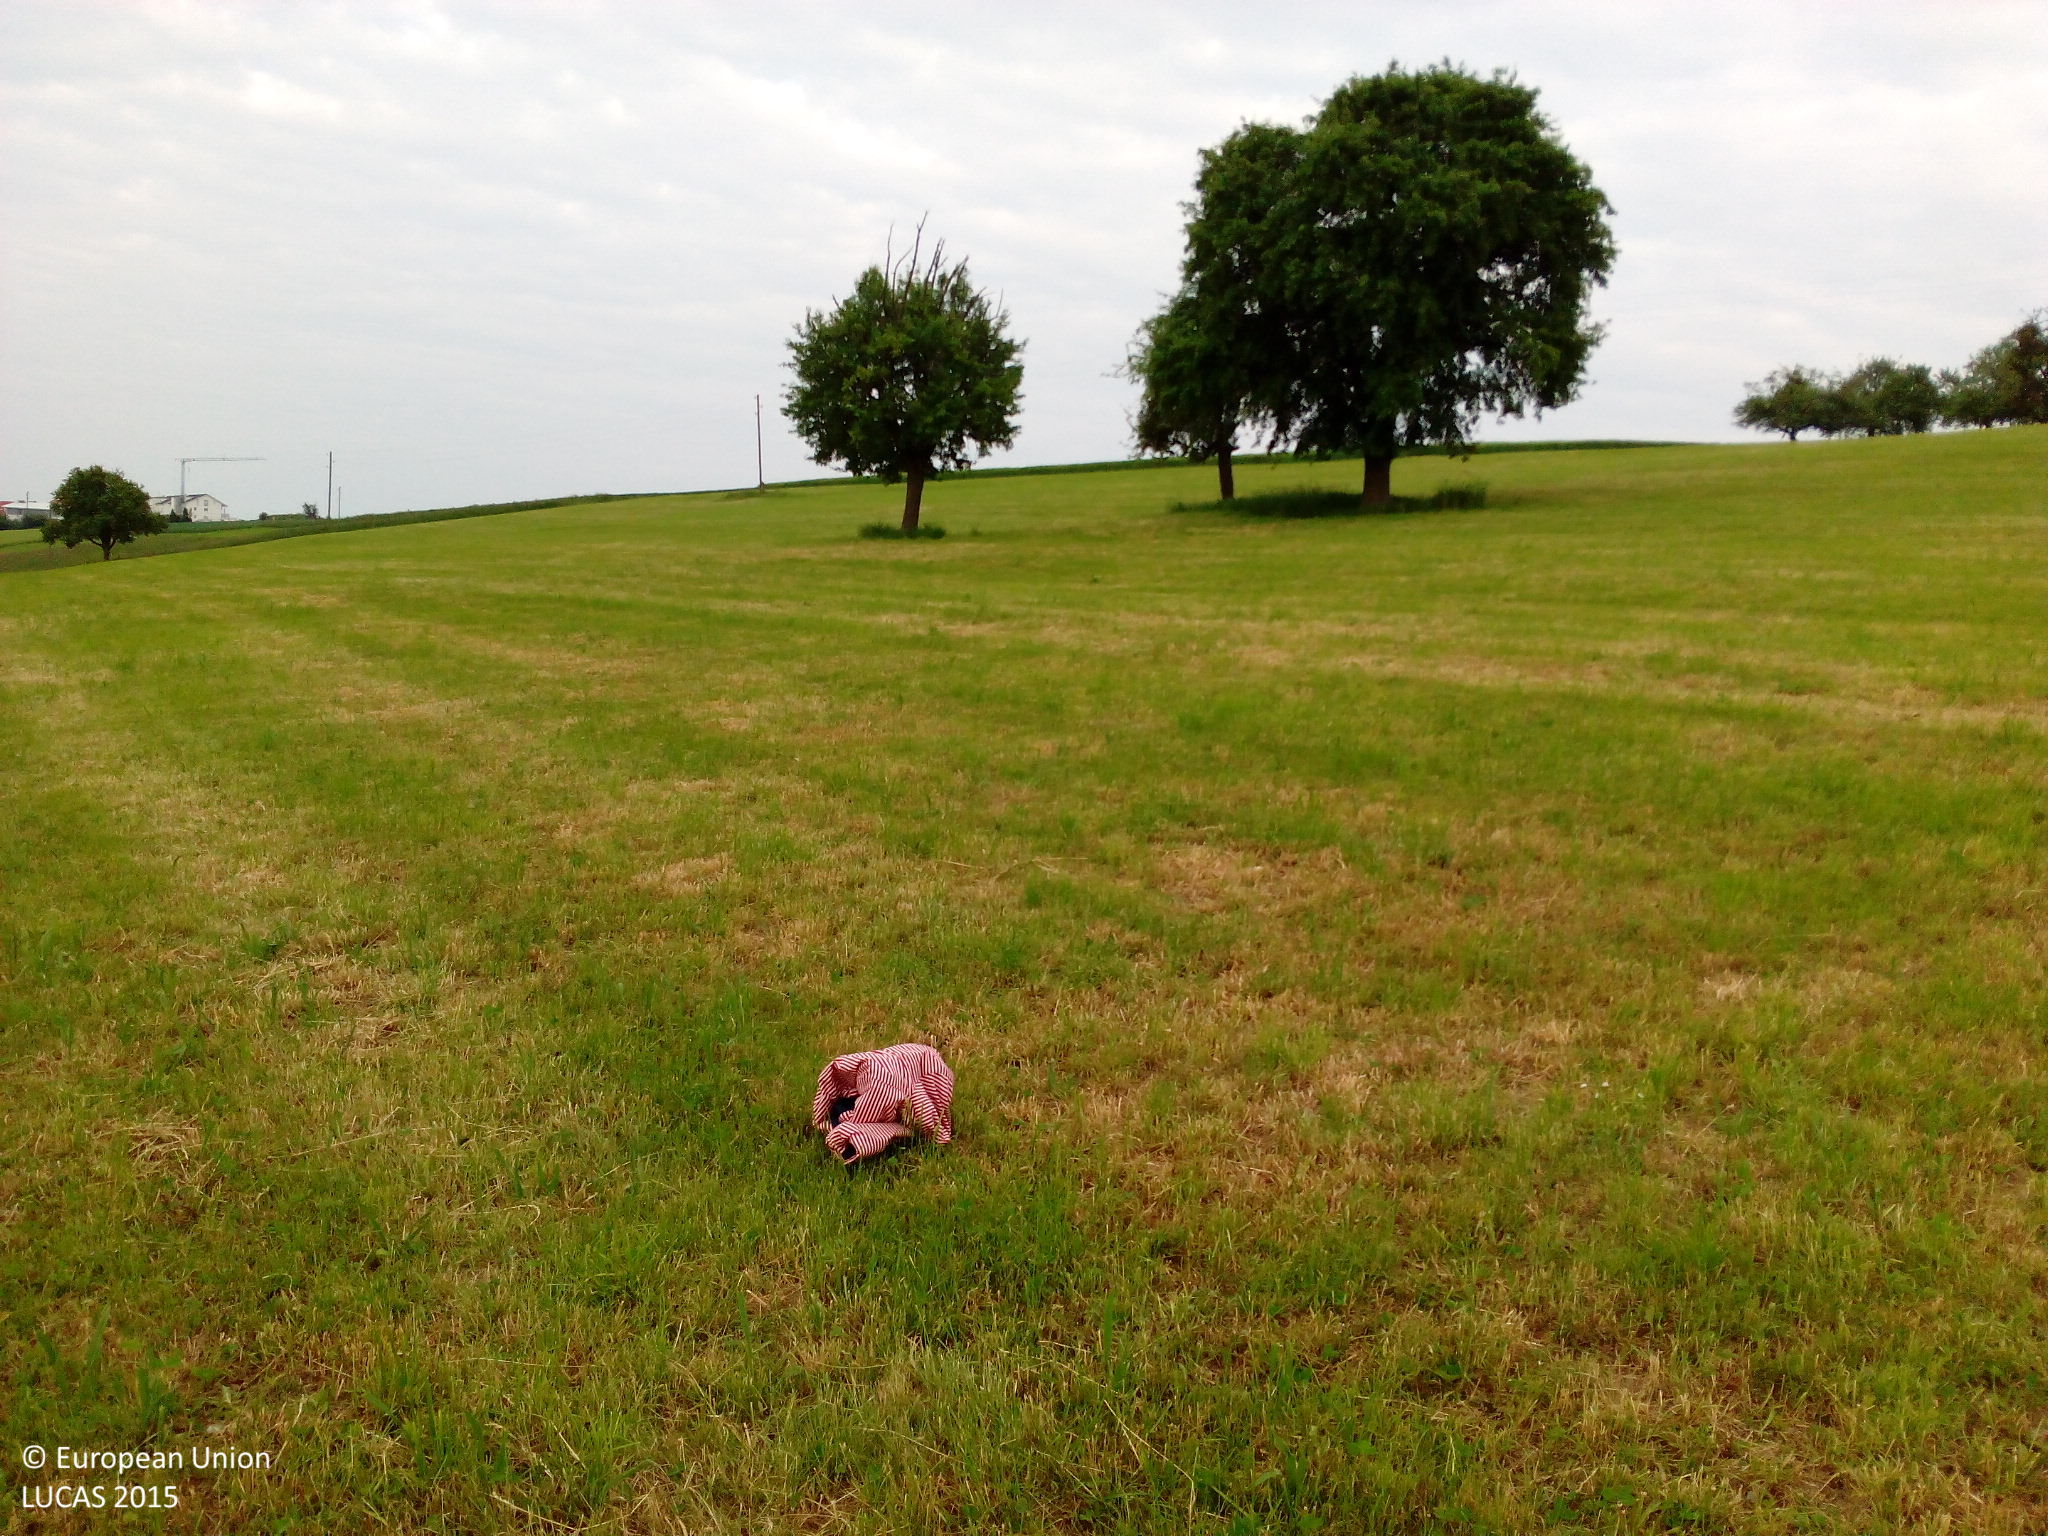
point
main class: Grassland
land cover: Grassland without tree/shrub cover
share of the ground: > 75 %
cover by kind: herbaceous plants 100 %
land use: Agriculture (excluding fallow land and kitchen gardens)
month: May
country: DE
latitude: 49.2843
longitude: 9.6015
